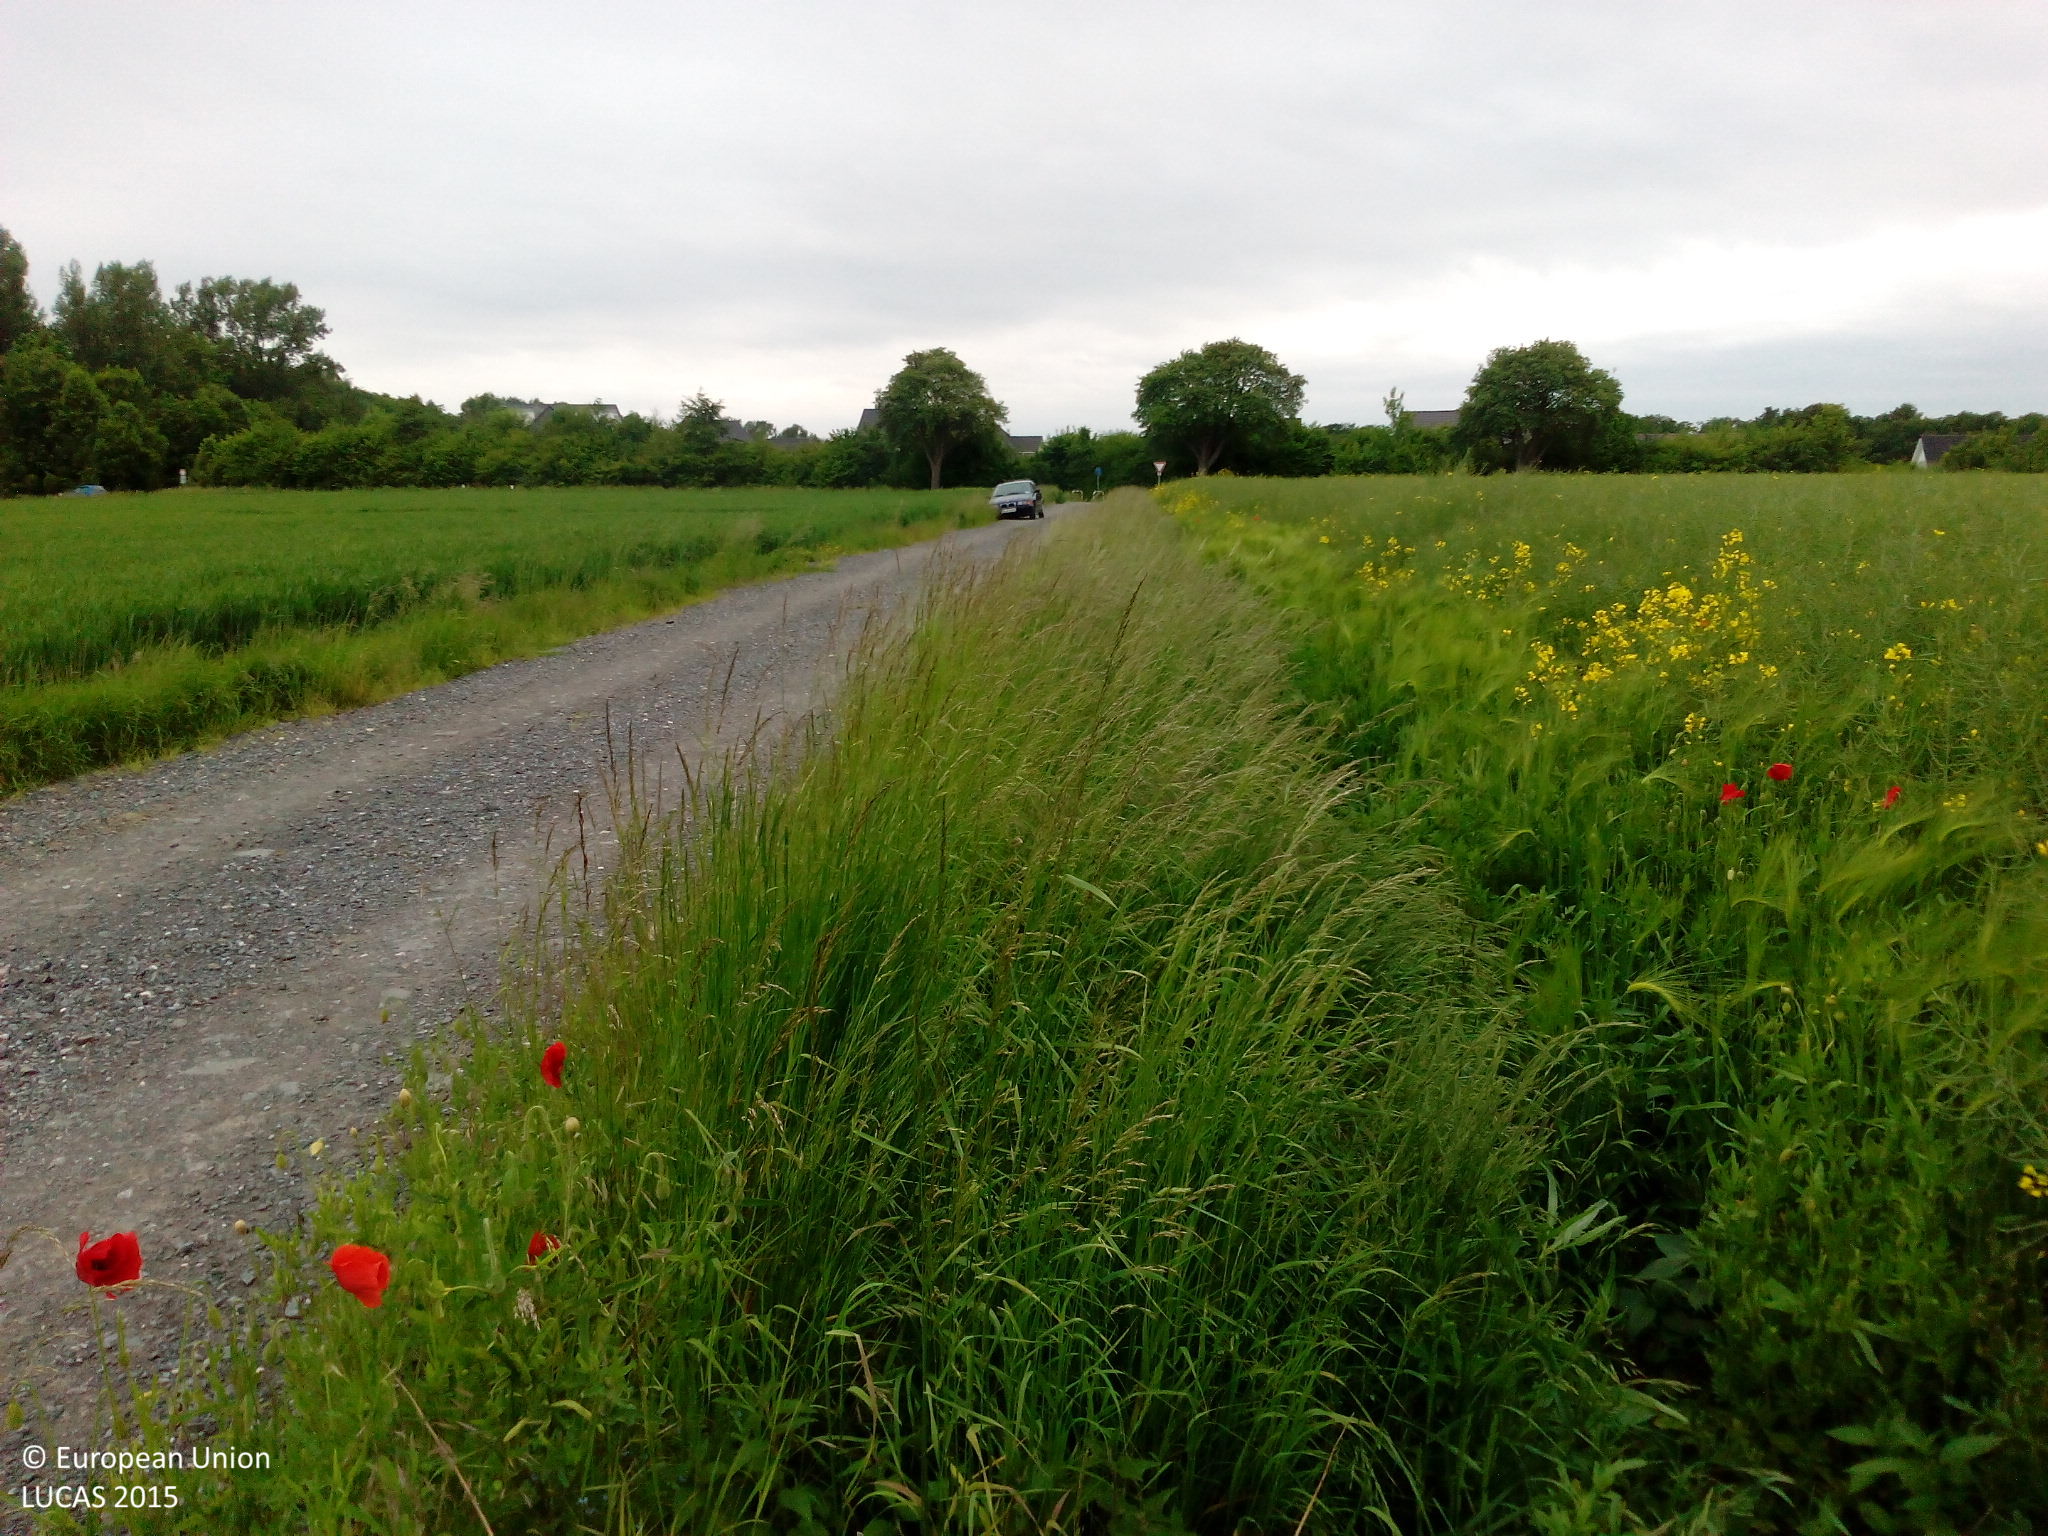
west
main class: Cropland
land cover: Rape and turnip rape
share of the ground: > 75 %
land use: Agriculture (excluding fallow land and kitchen gardens)
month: June
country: DE
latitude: 51.4791
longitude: 7.9701
